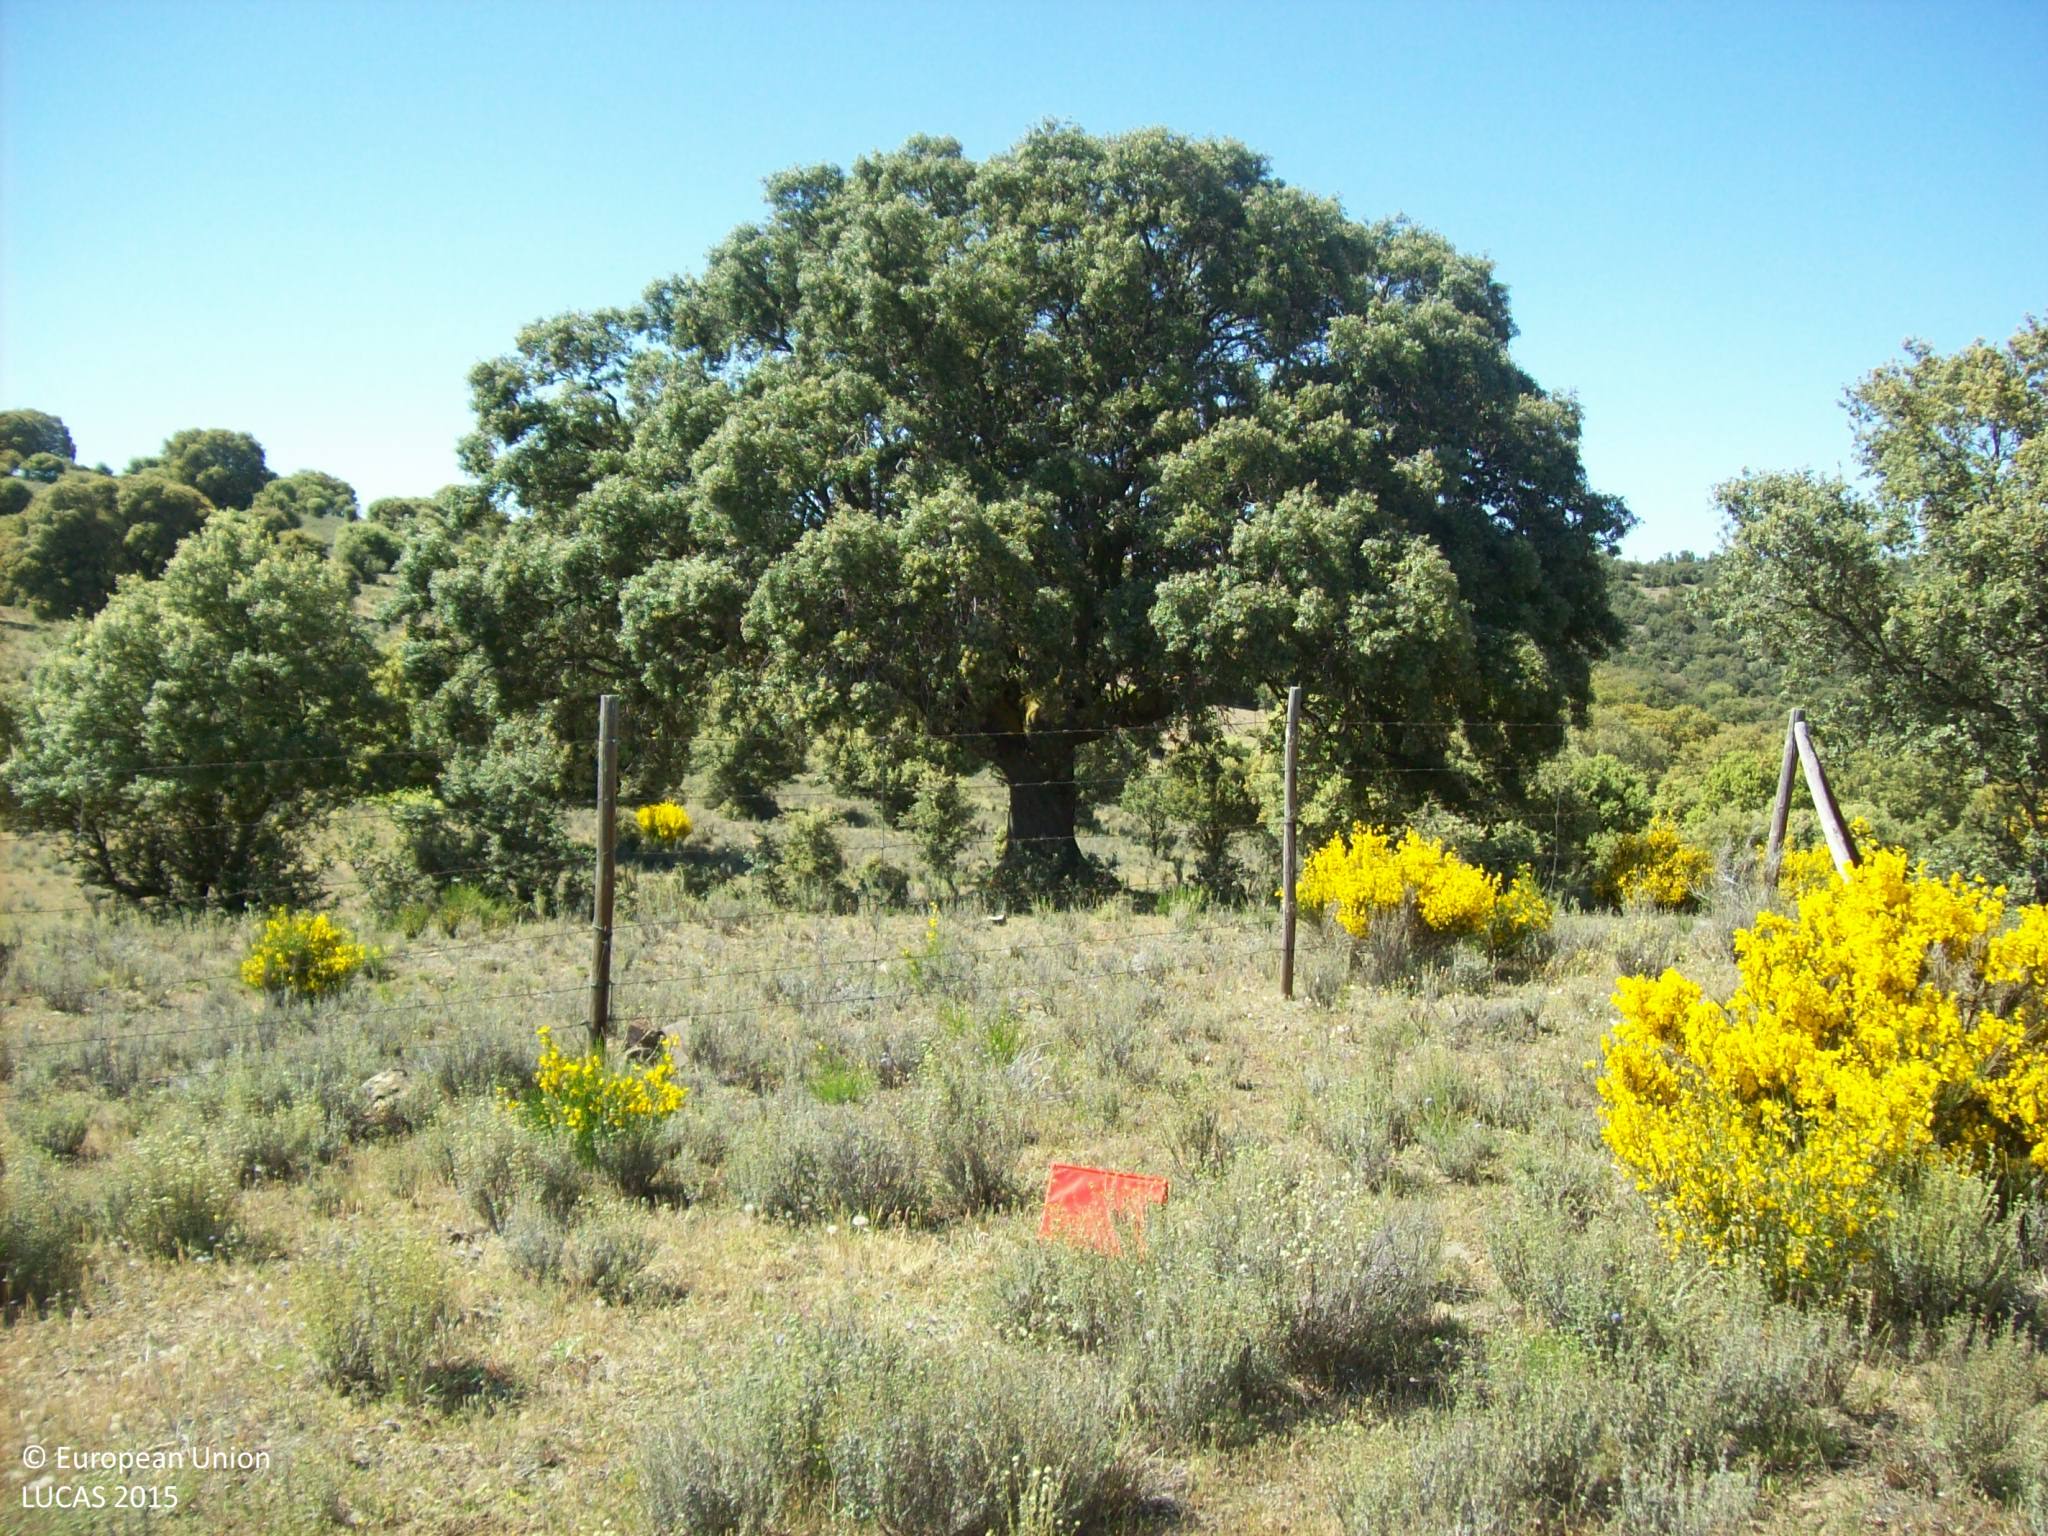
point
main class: Woodland
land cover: Broadleaved woodland
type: acidophilous oak and oak-birch forest
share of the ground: 10 - 25 %
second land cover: Shrubland without tree cover
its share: 50 - 75 %
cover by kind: shrubs 40 %, herbaceous plants 40 %, broadleaved forest trees 10 %, lichens and mosses 10 %
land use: Forestry
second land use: Agriculture (excluding fallow land and kitchen gardens)
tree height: > 5 m
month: May
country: ES
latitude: 40.7275
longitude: -4.9674
